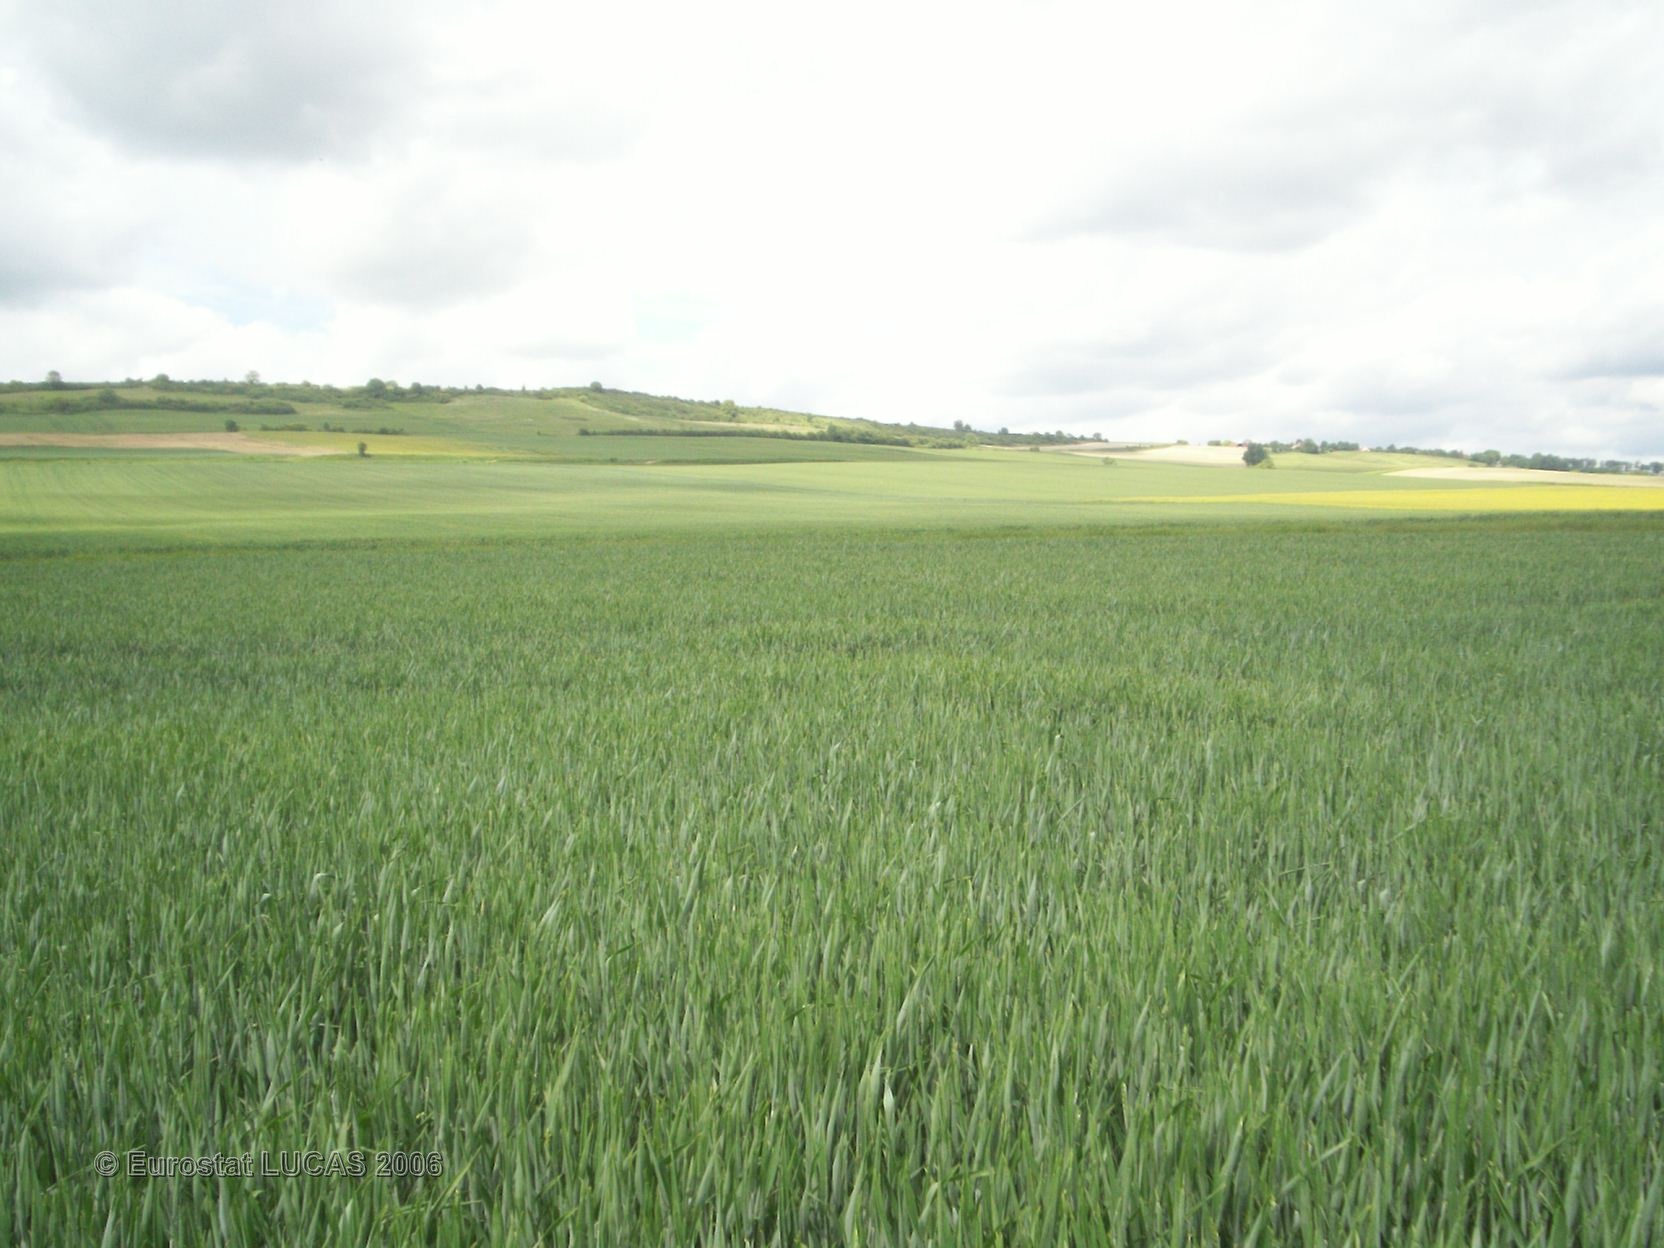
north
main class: Cropland
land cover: Common wheat
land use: Agriculture (excluding fallow land and kitchen gardens)
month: May
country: FR
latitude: 46.1675
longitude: 3.1473
